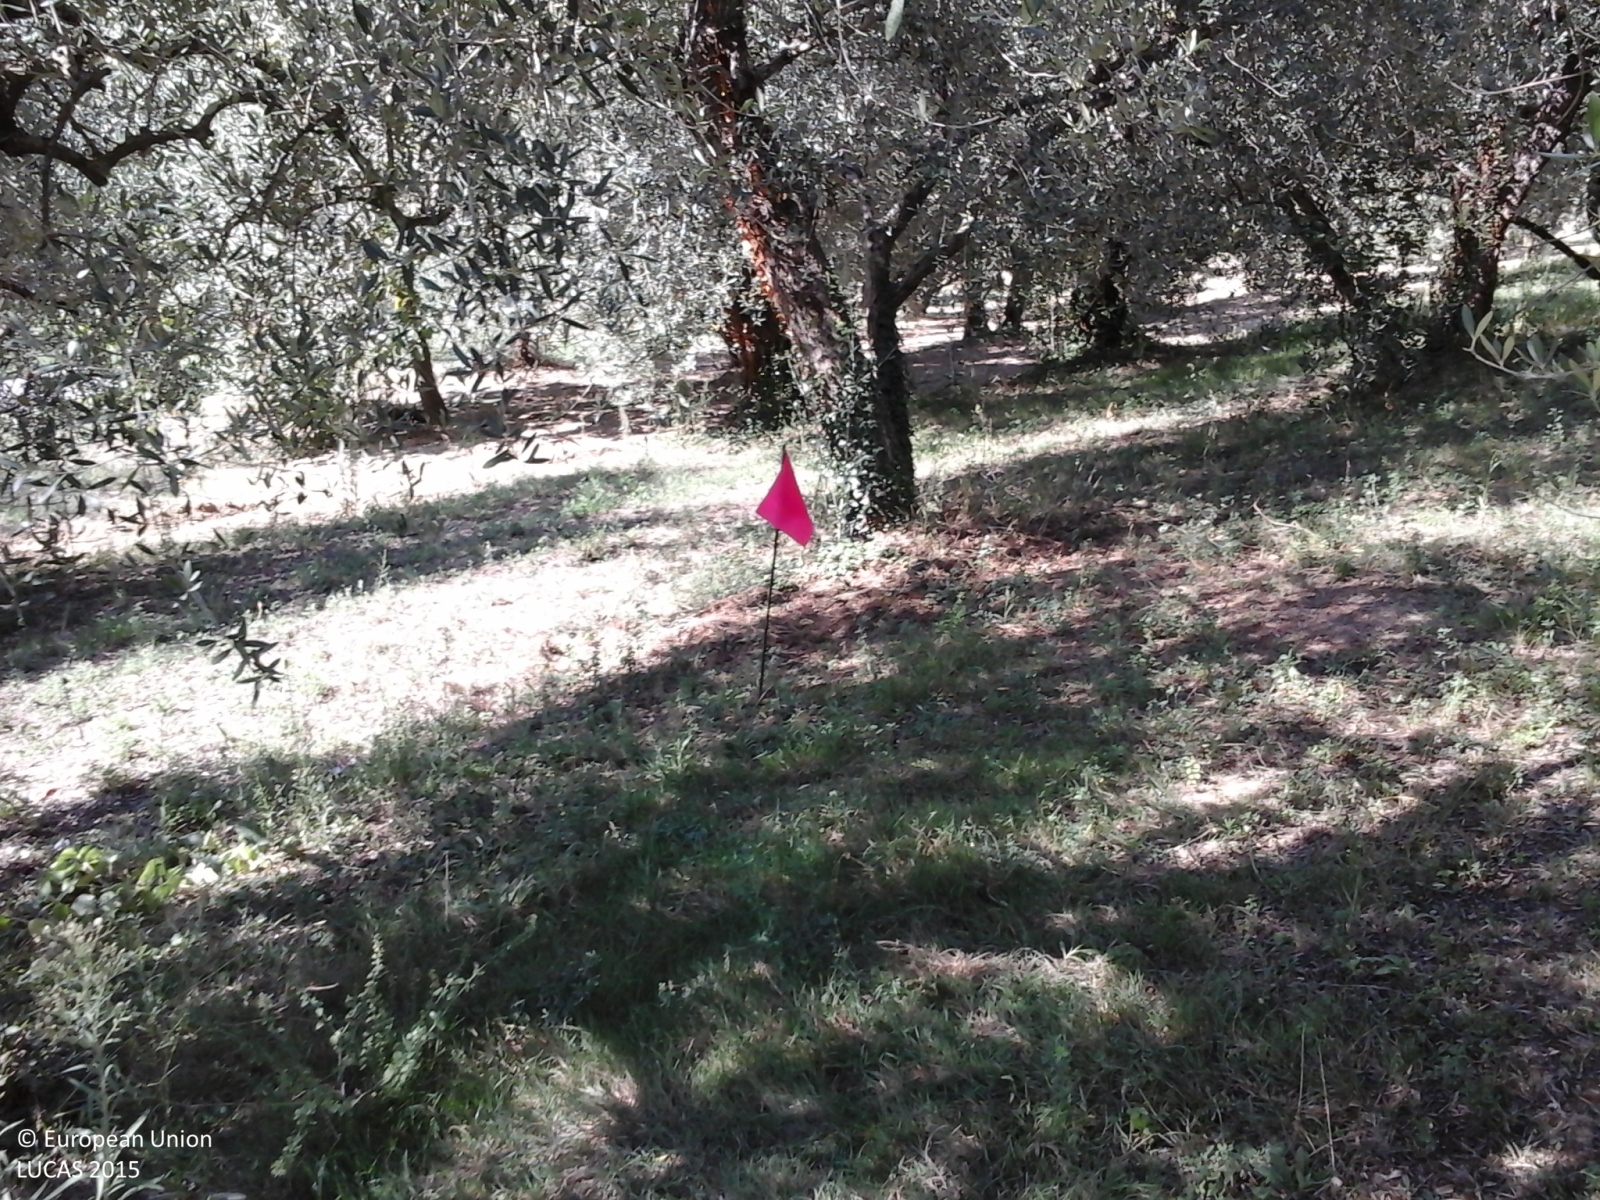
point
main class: Cropland
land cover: Olive groves
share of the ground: > 75 %
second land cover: Grassland without tree/shrub cover
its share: > 75 %
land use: Agriculture (excluding fallow land and kitchen gardens)
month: September
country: IT
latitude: 43.8777
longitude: 12.8682
